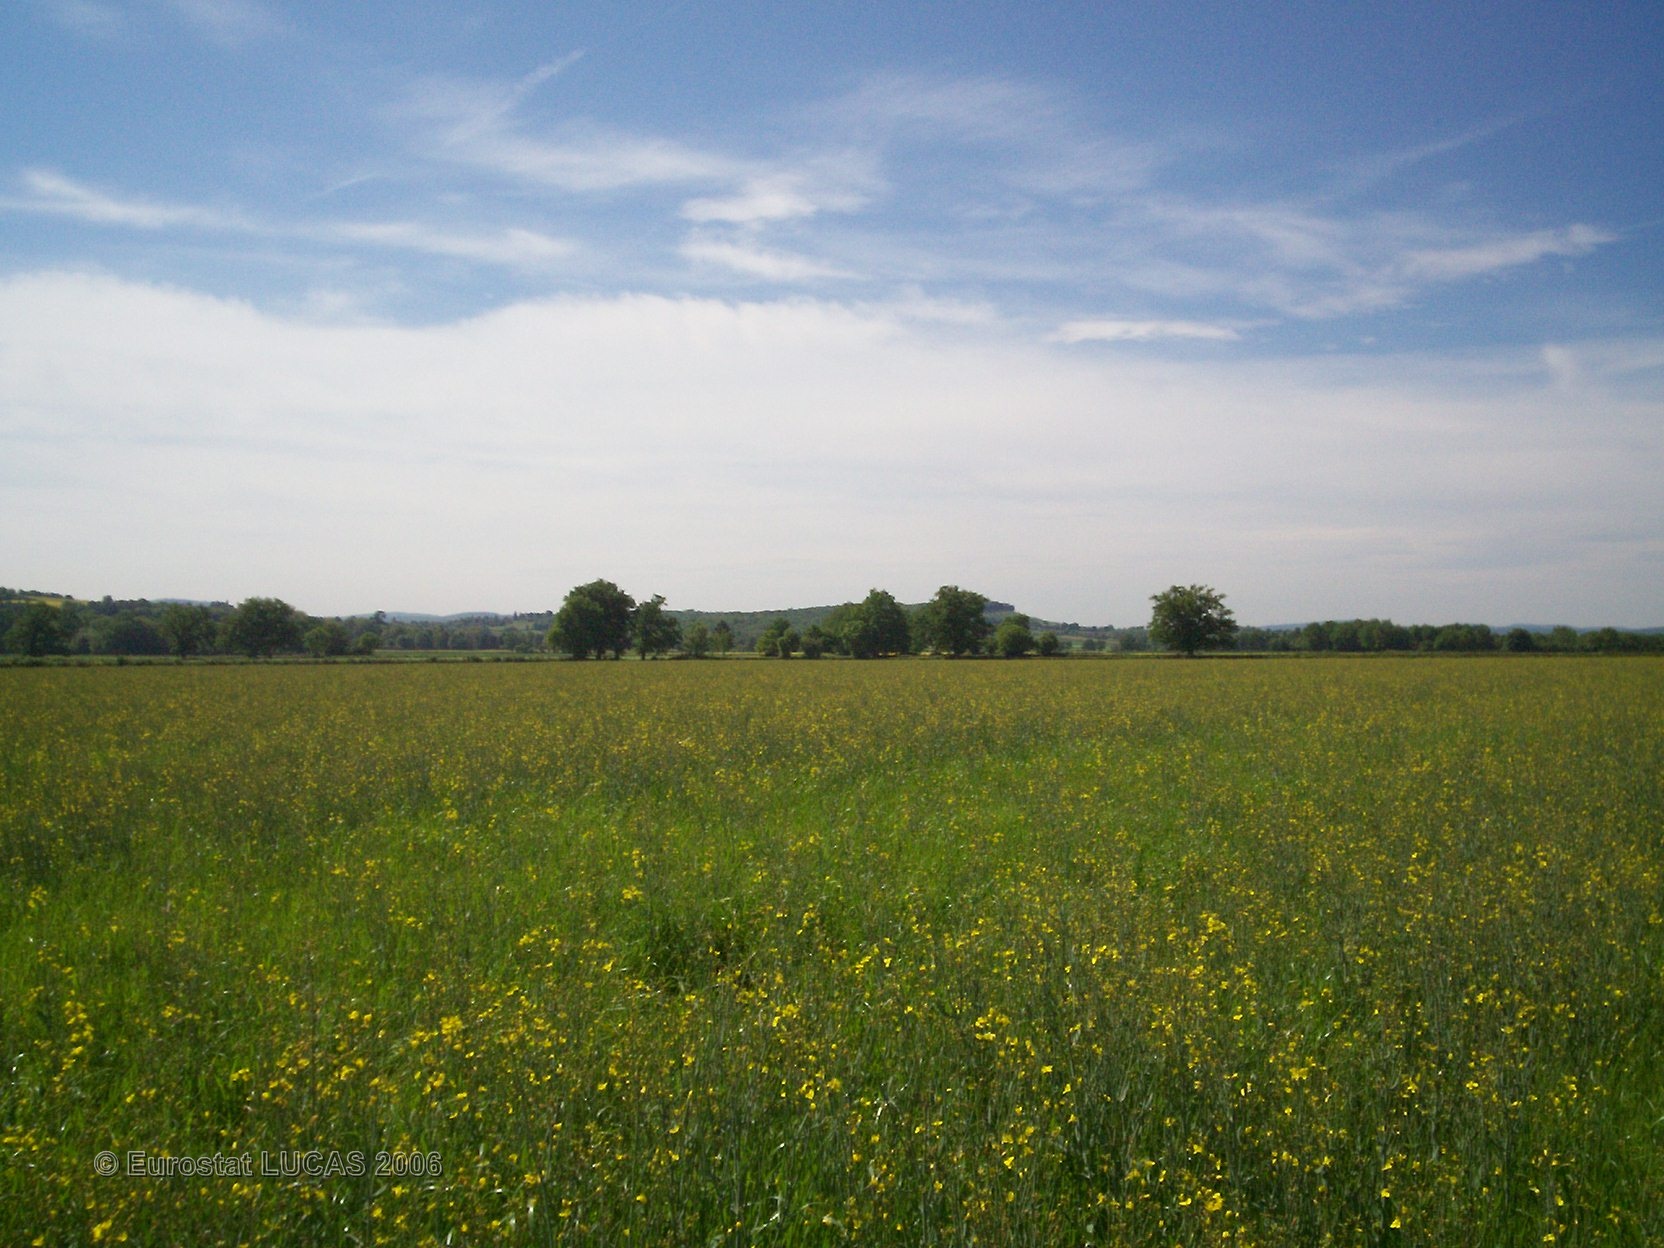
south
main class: Grassland
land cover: Grassland without tree/shrub cover
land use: Agriculture (excluding fallow land and kitchen gardens)
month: May
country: FR
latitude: 46.5996
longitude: 4.7146
